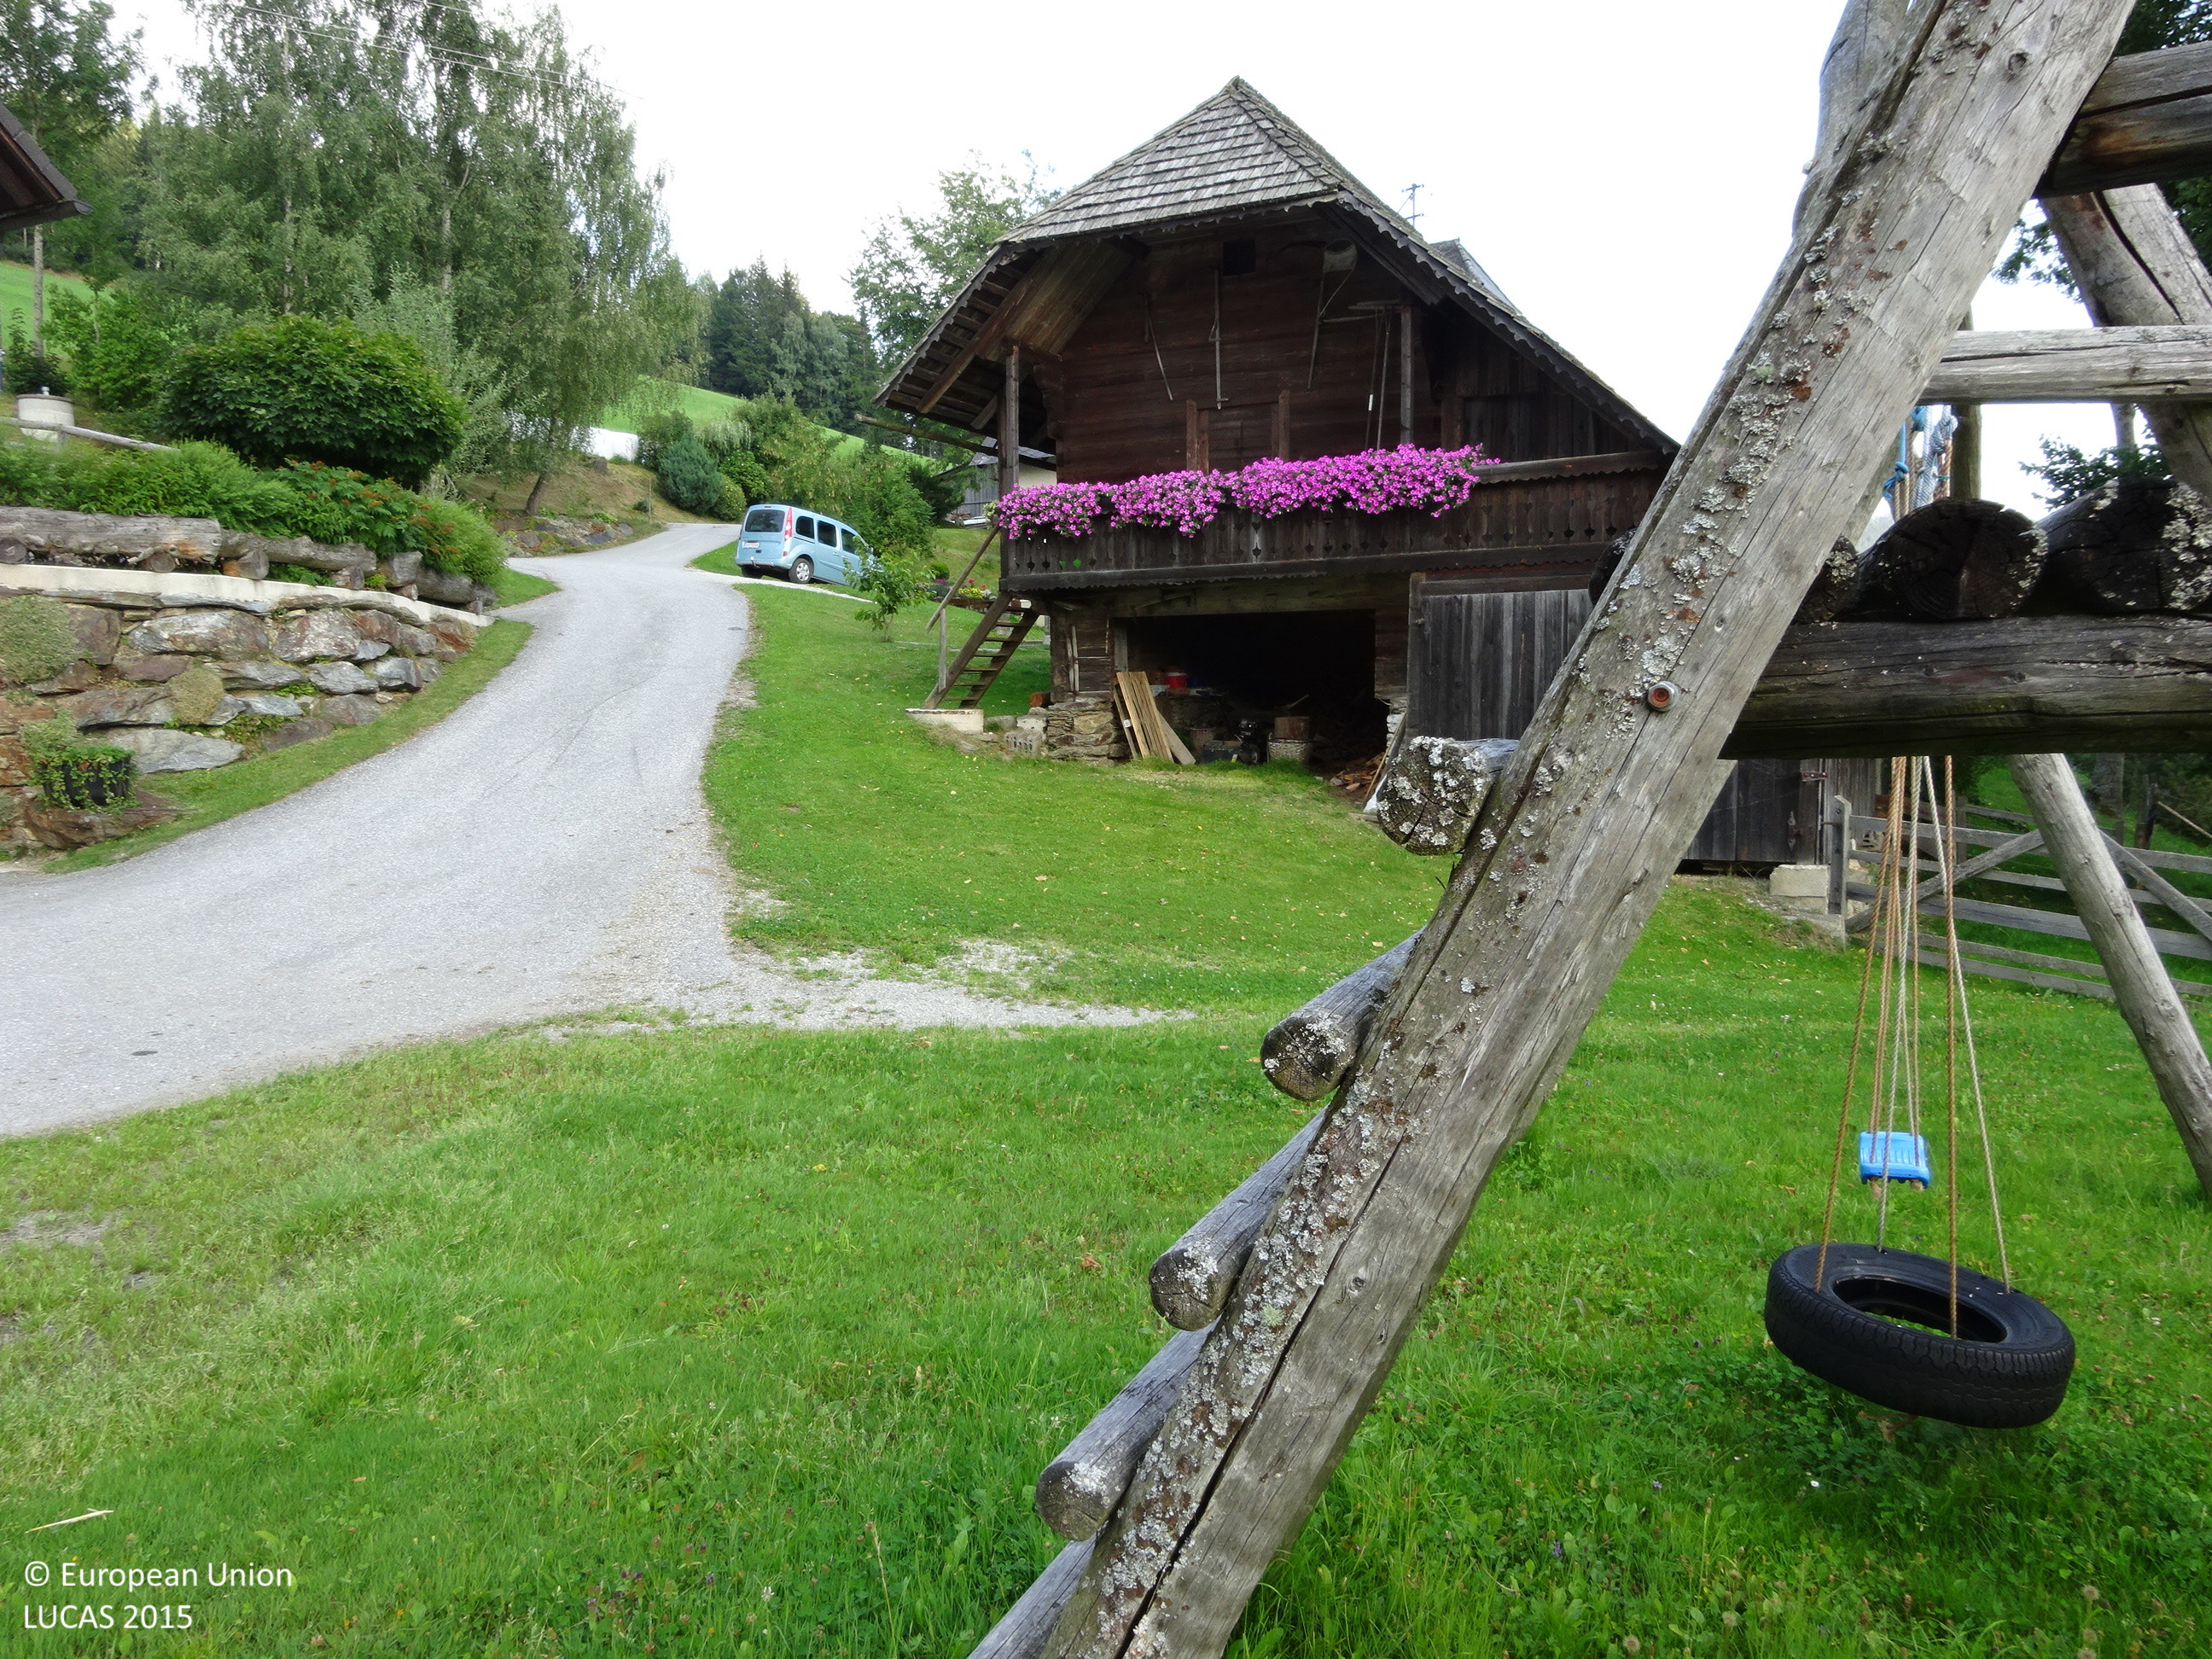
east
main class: Grassland
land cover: Grassland without tree/shrub cover
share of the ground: > 75 %
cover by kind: herbaceous plants 100 %
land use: Amenities, museums, leisure
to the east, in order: Grassland without tree/shrub cover; Artificial constructions in urban areas; Grassland without tree/shrub cover
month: August
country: AT
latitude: 47.5127
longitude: 15.7777
